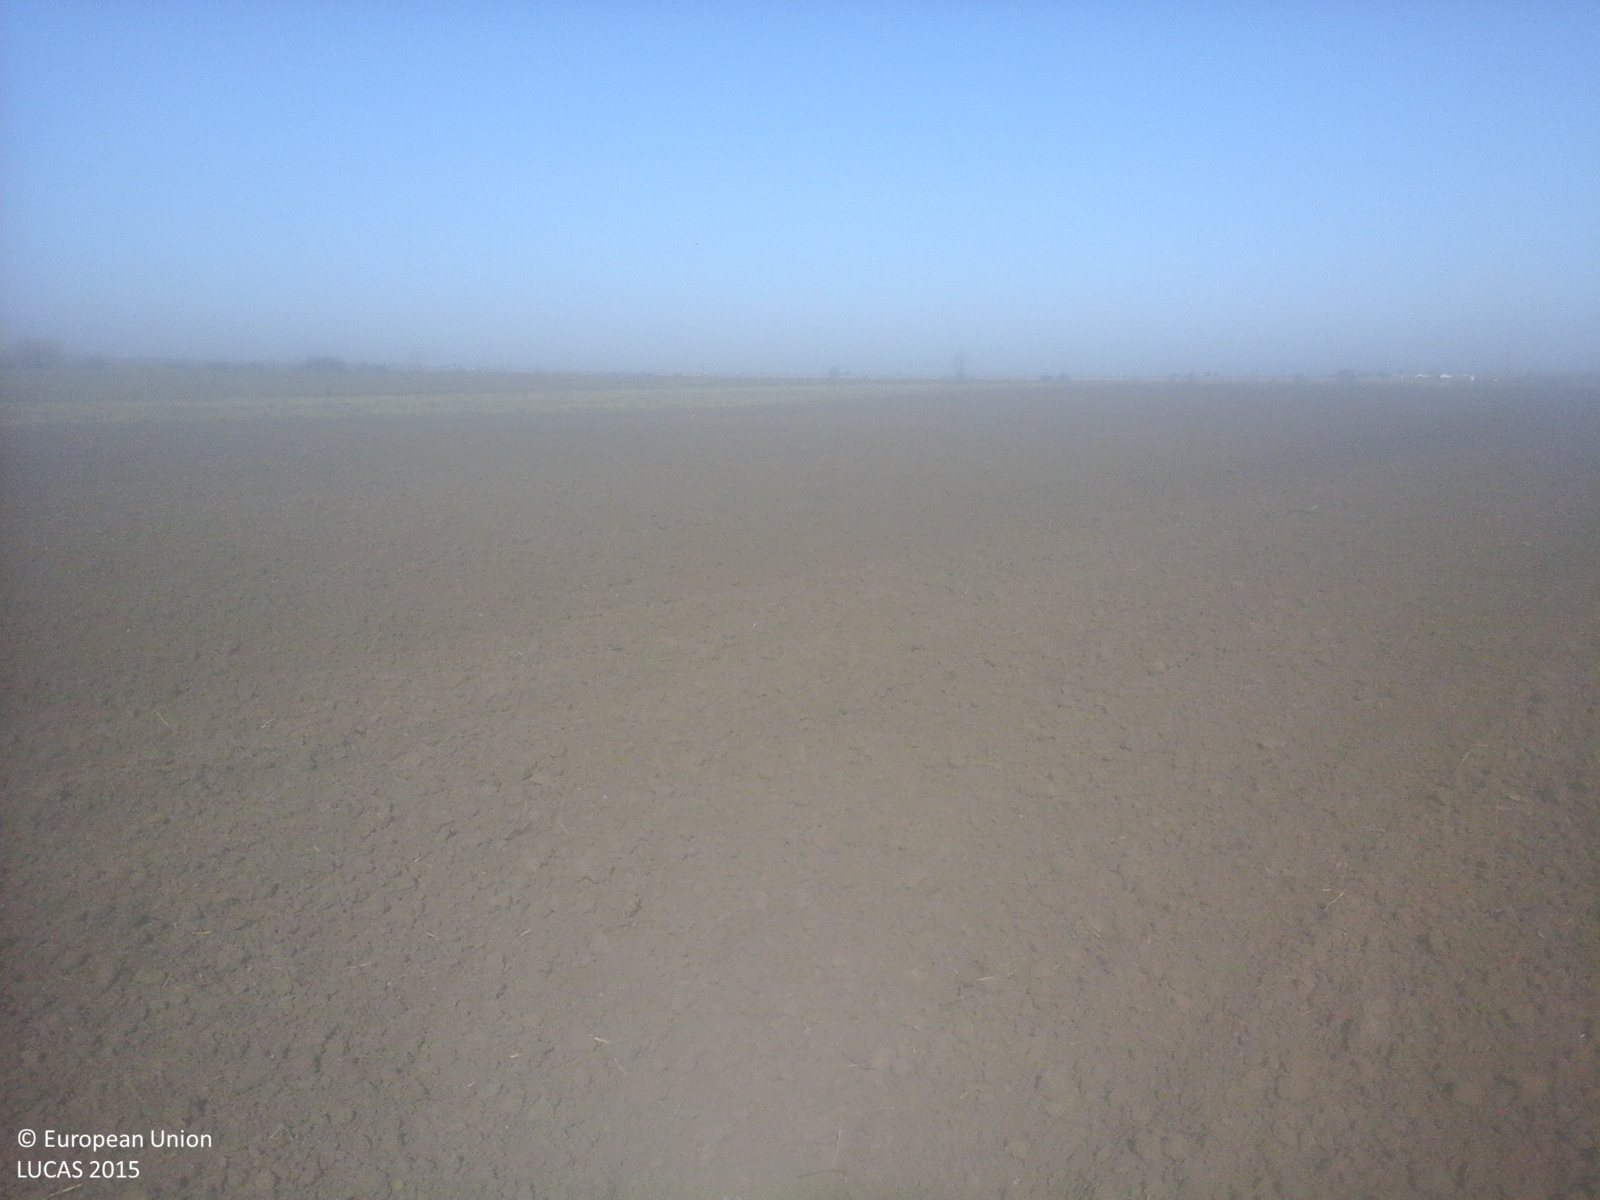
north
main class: Cropland
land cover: Common wheat
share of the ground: < 10 %
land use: Agriculture (excluding fallow land and kitchen gardens)
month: October
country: RO
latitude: 45.8568
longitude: 27.1340
